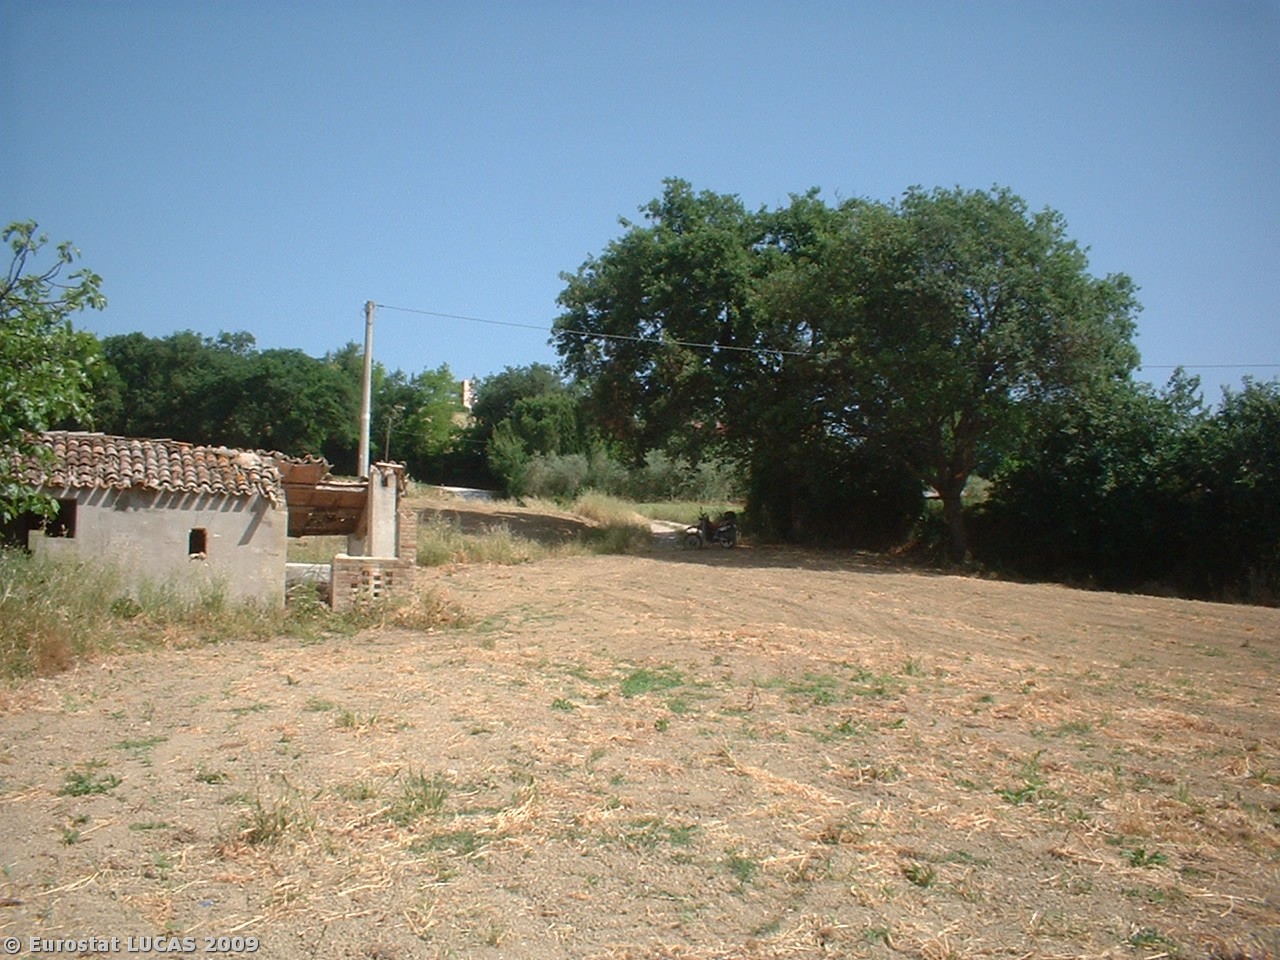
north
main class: Cropland
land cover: Sunflower
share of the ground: < 10 %
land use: Agriculture (excluding fallow land and kitchen gardens)
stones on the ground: < 10 %
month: May
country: IT
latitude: 43.1633
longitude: 13.7416
